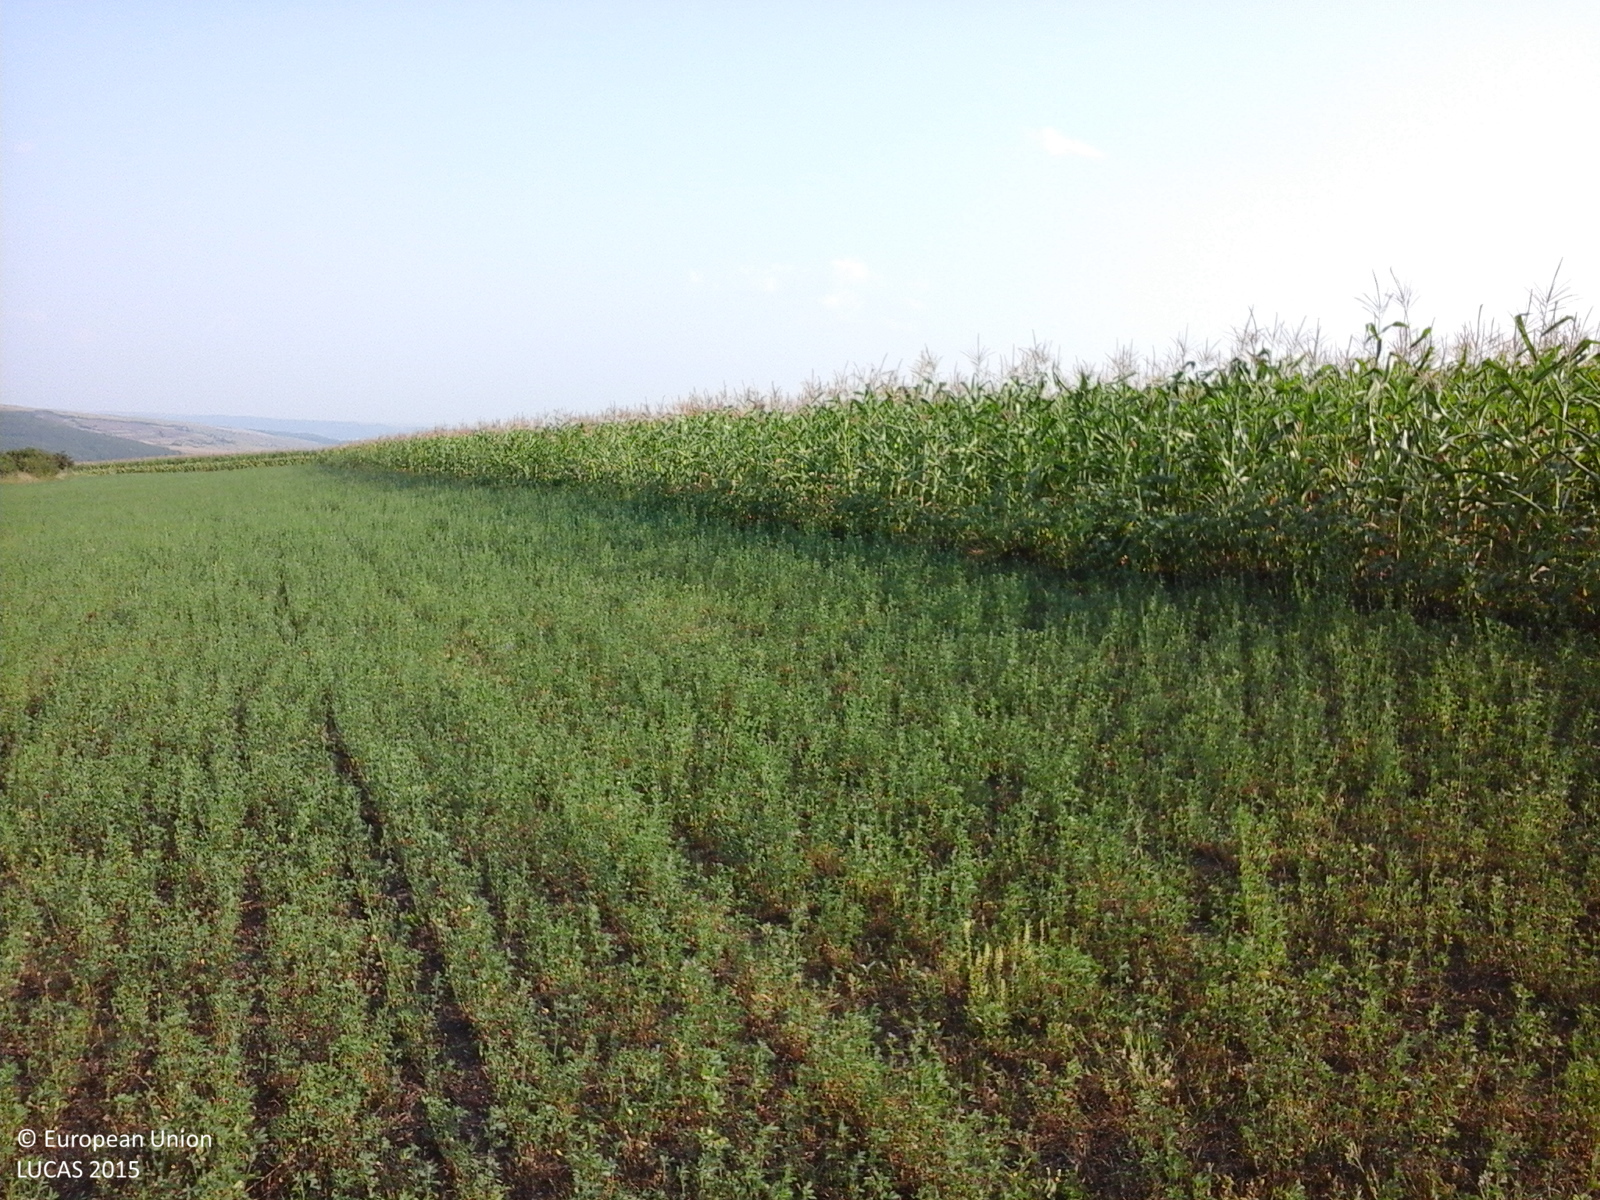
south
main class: Cropland
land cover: Lucerne
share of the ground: > 75 %
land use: Agriculture (excluding fallow land and kitchen gardens)
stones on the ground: < 10 %
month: July
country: RO
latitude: 46.3086
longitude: 27.6296
